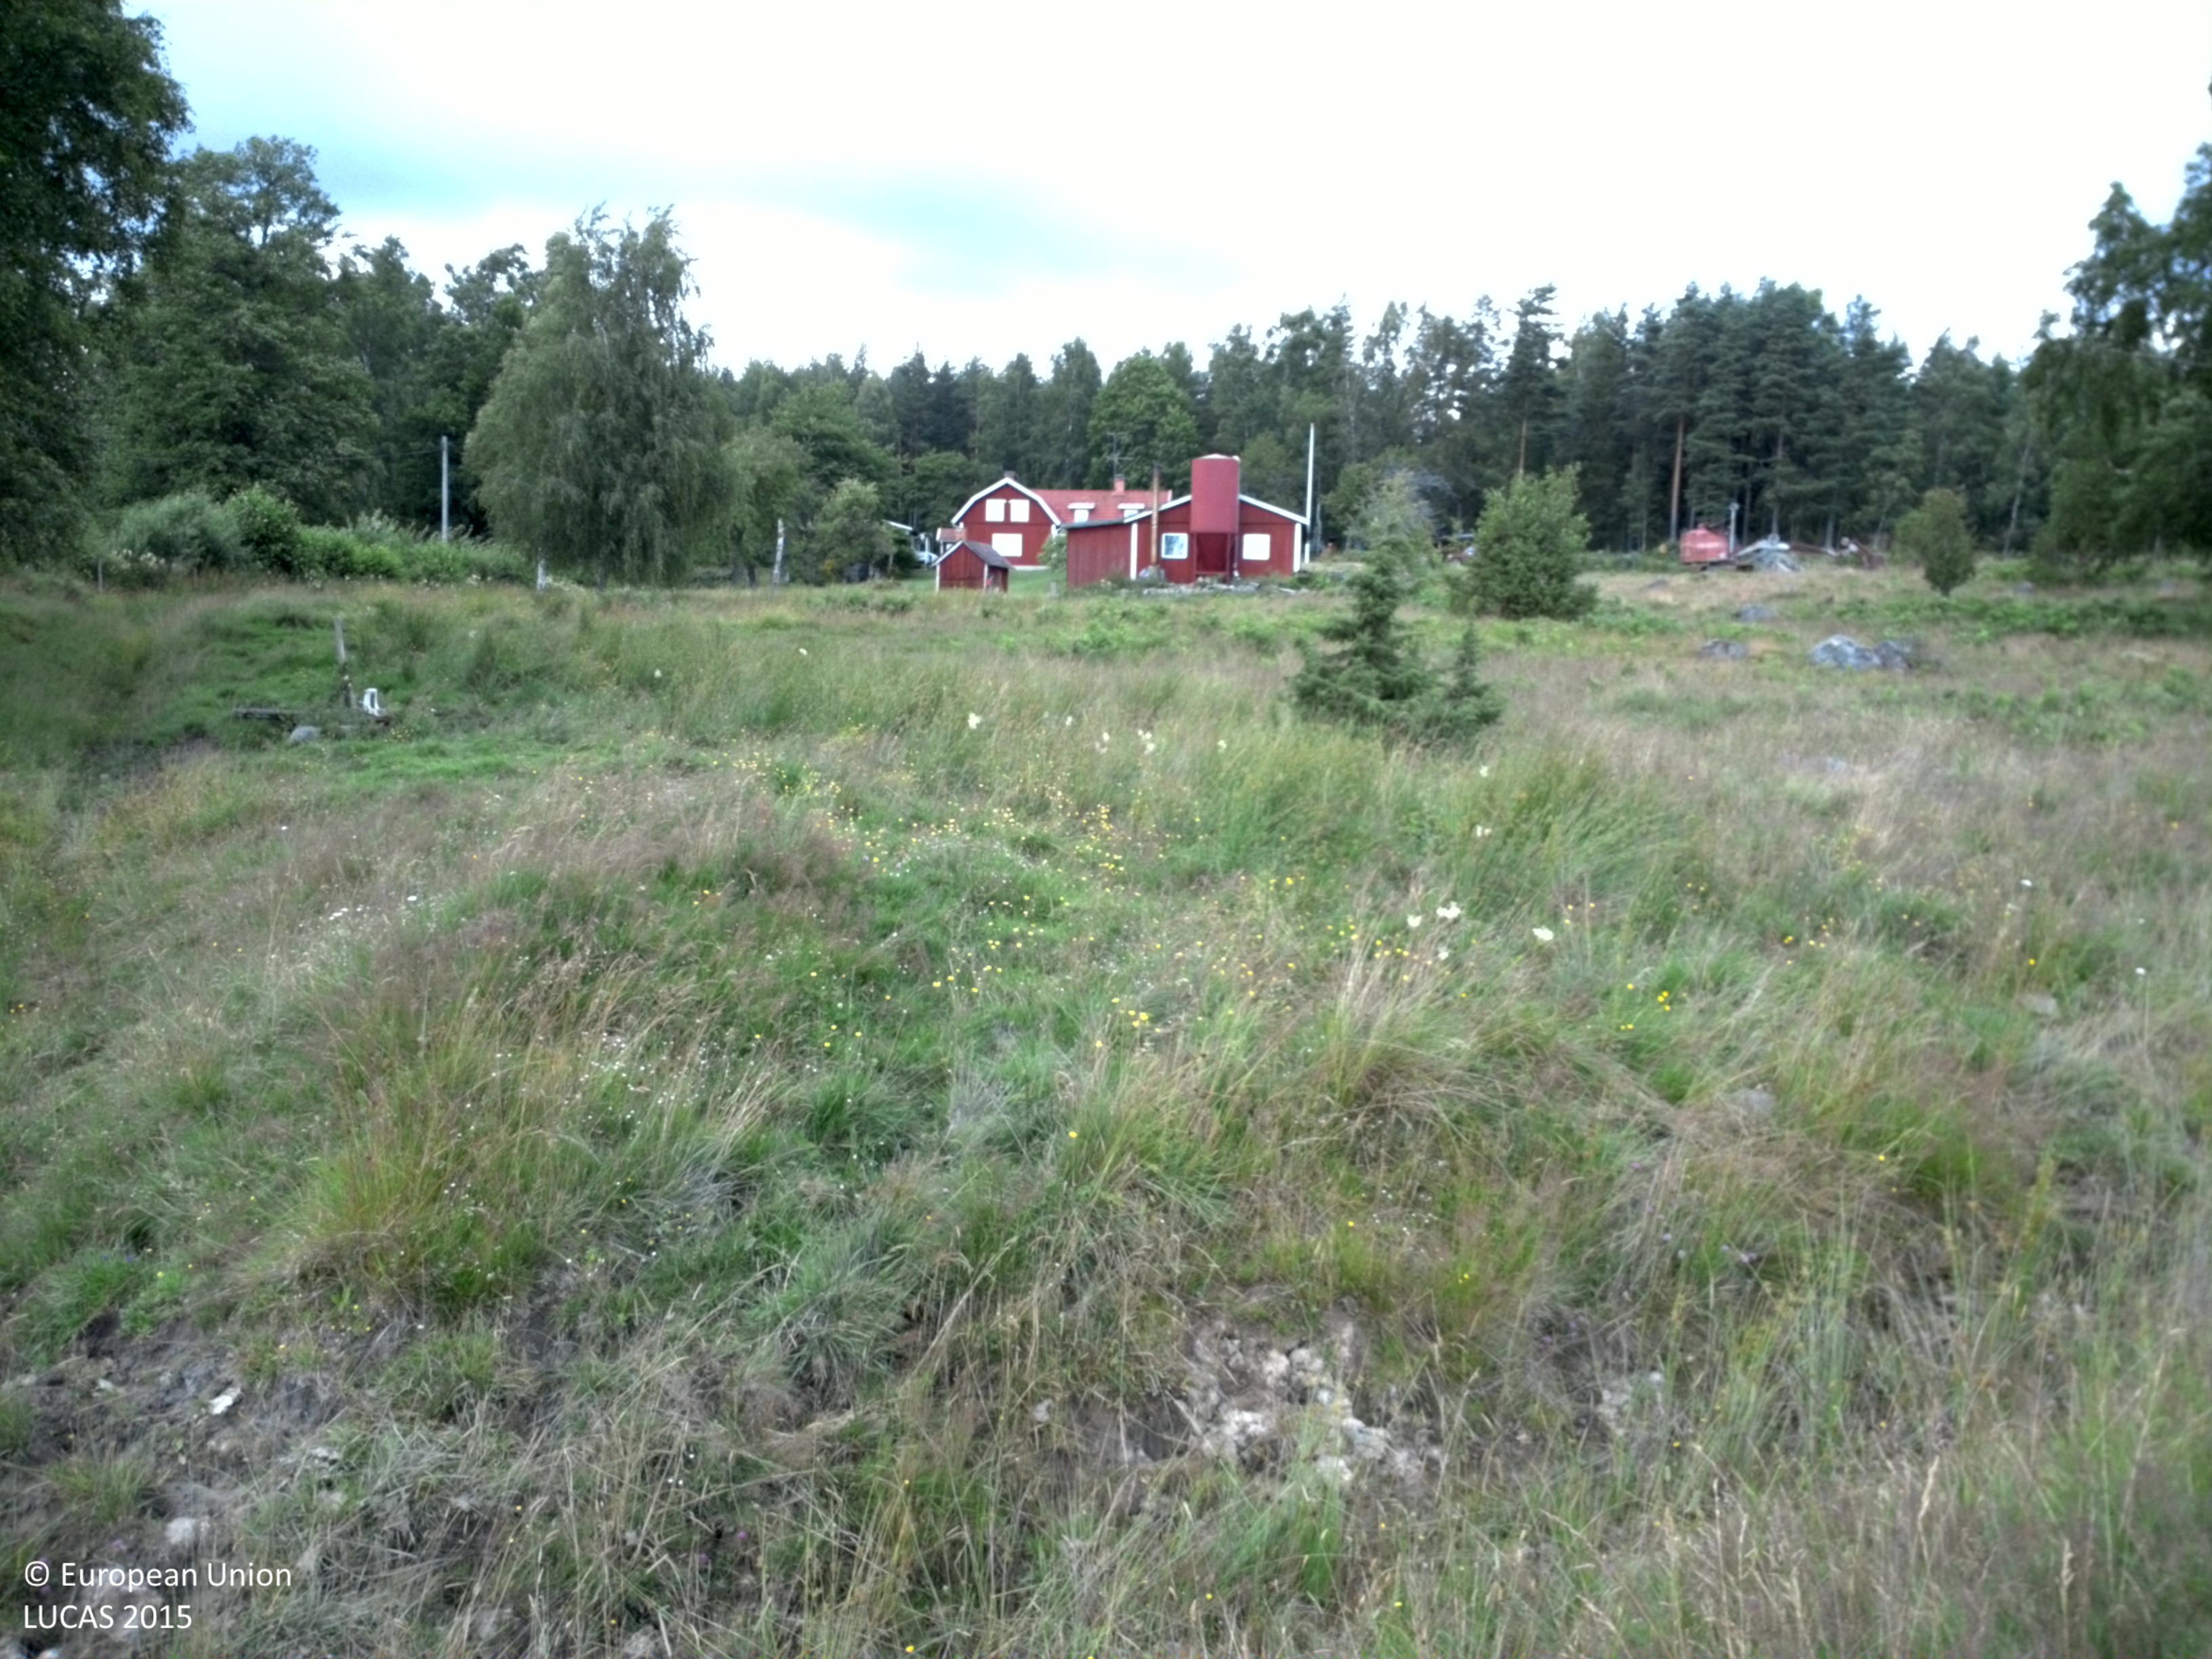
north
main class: Grassland
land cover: Grassland without tree/shrub cover
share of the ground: > 75 %
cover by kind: herbaceous plants 100 %
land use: Agriculture (excluding fallow land and kitchen gardens)
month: July
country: SE
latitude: 58.7532
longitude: 15.5762
